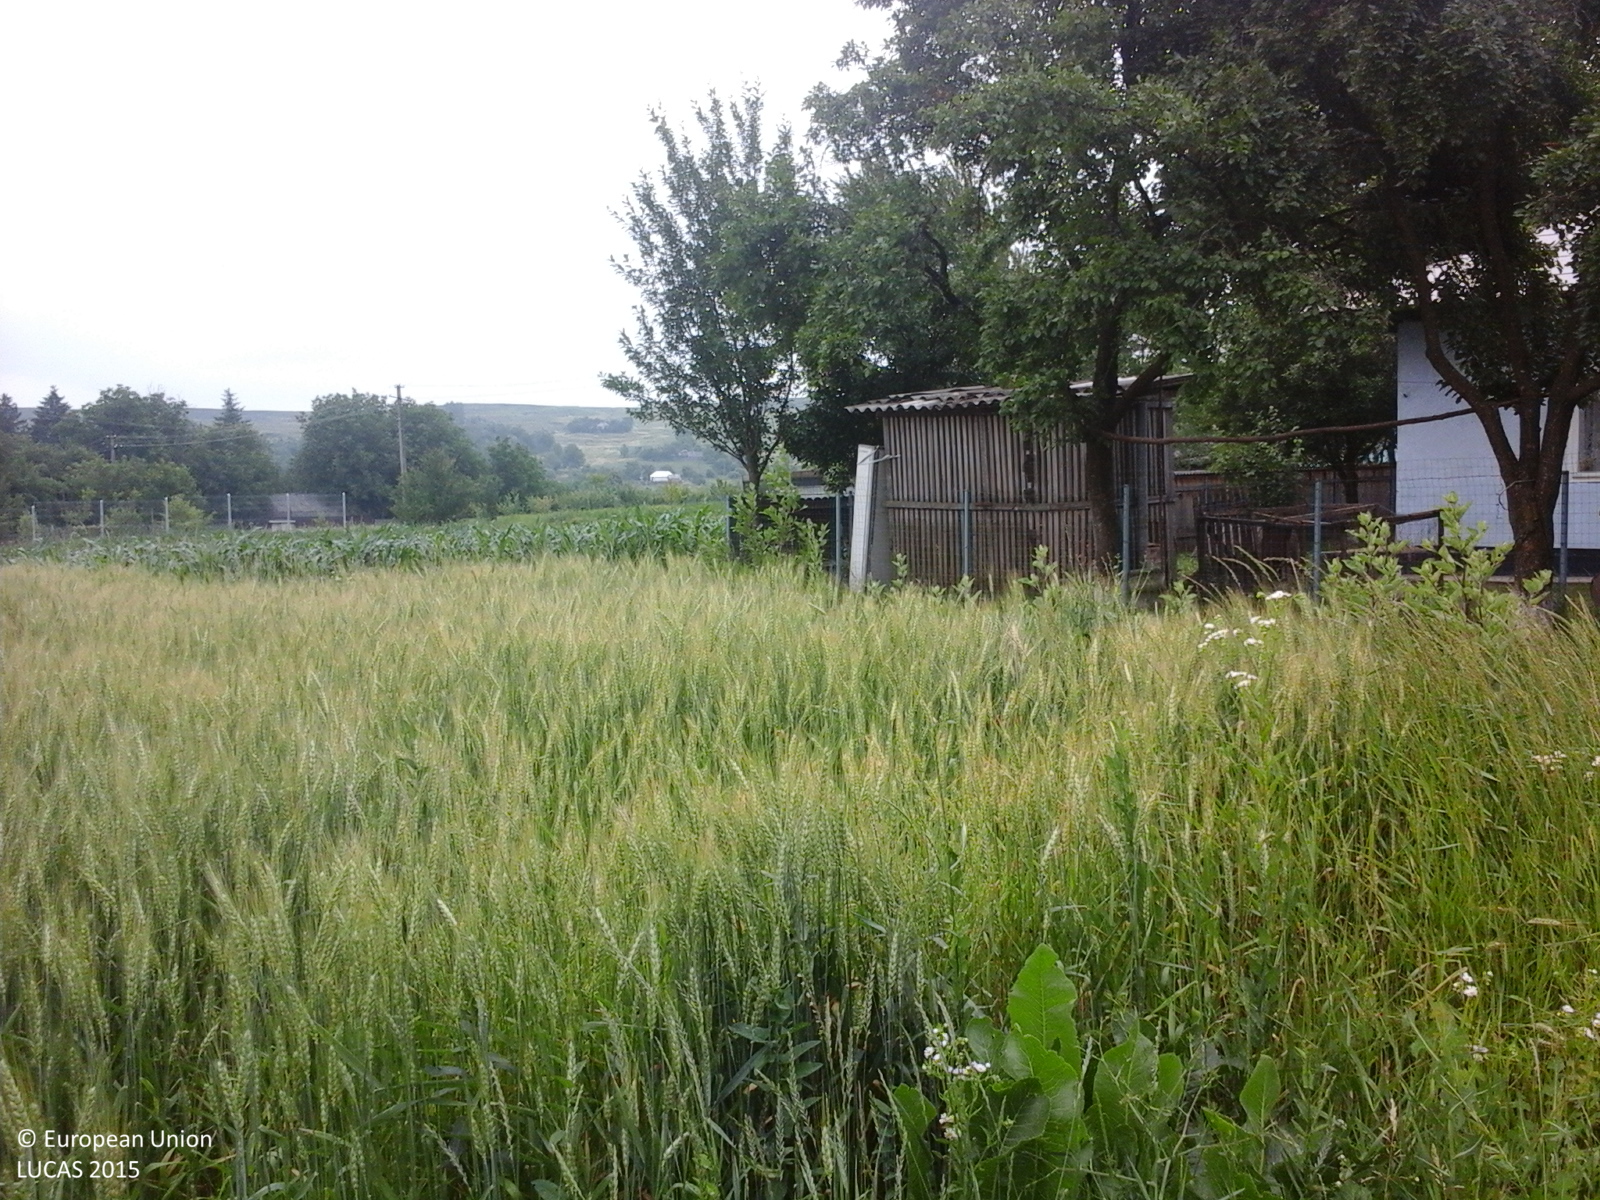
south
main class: Cropland
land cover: Potatoes
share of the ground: > 75 %
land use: Agriculture (excluding fallow land and kitchen gardens)
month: June
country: RO
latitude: 48.1206
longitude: 26.4124
